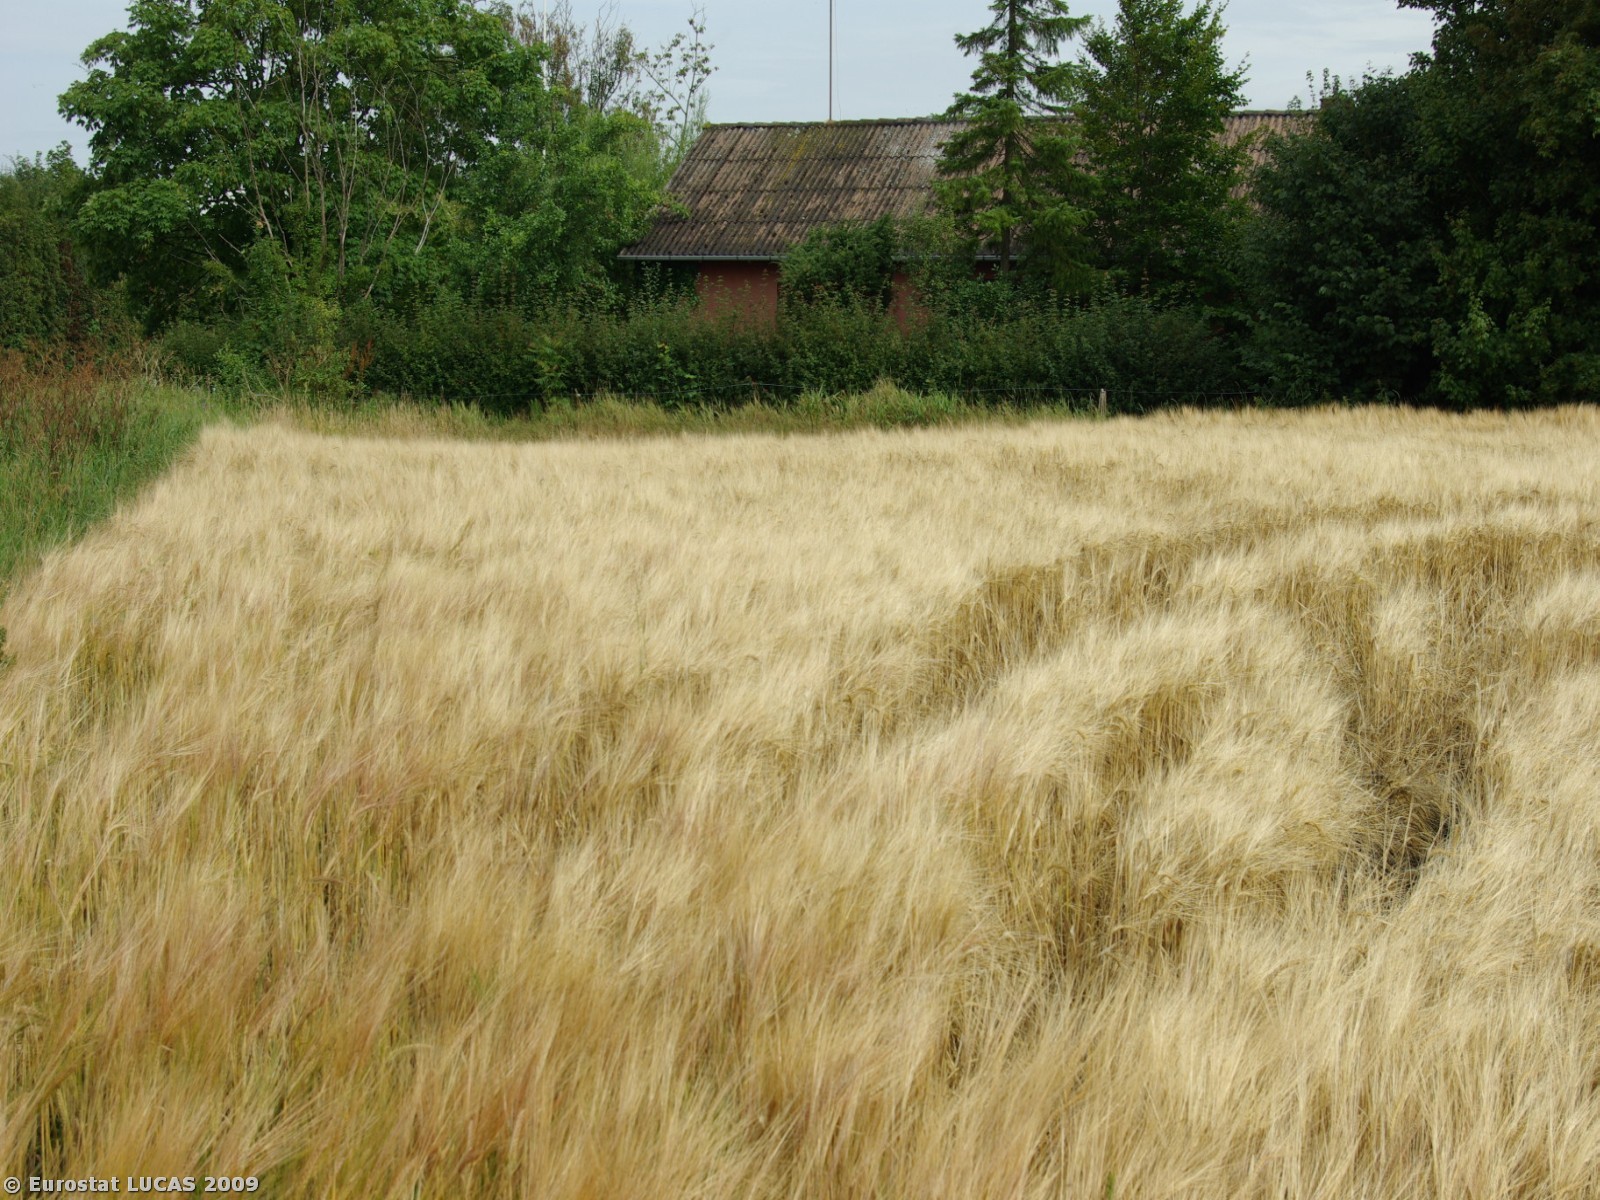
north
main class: Cropland
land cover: Barley
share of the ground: > 75 %
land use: Agriculture (excluding fallow land and kitchen gardens)
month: July
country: DK
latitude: 55.2643
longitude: 8.6949
